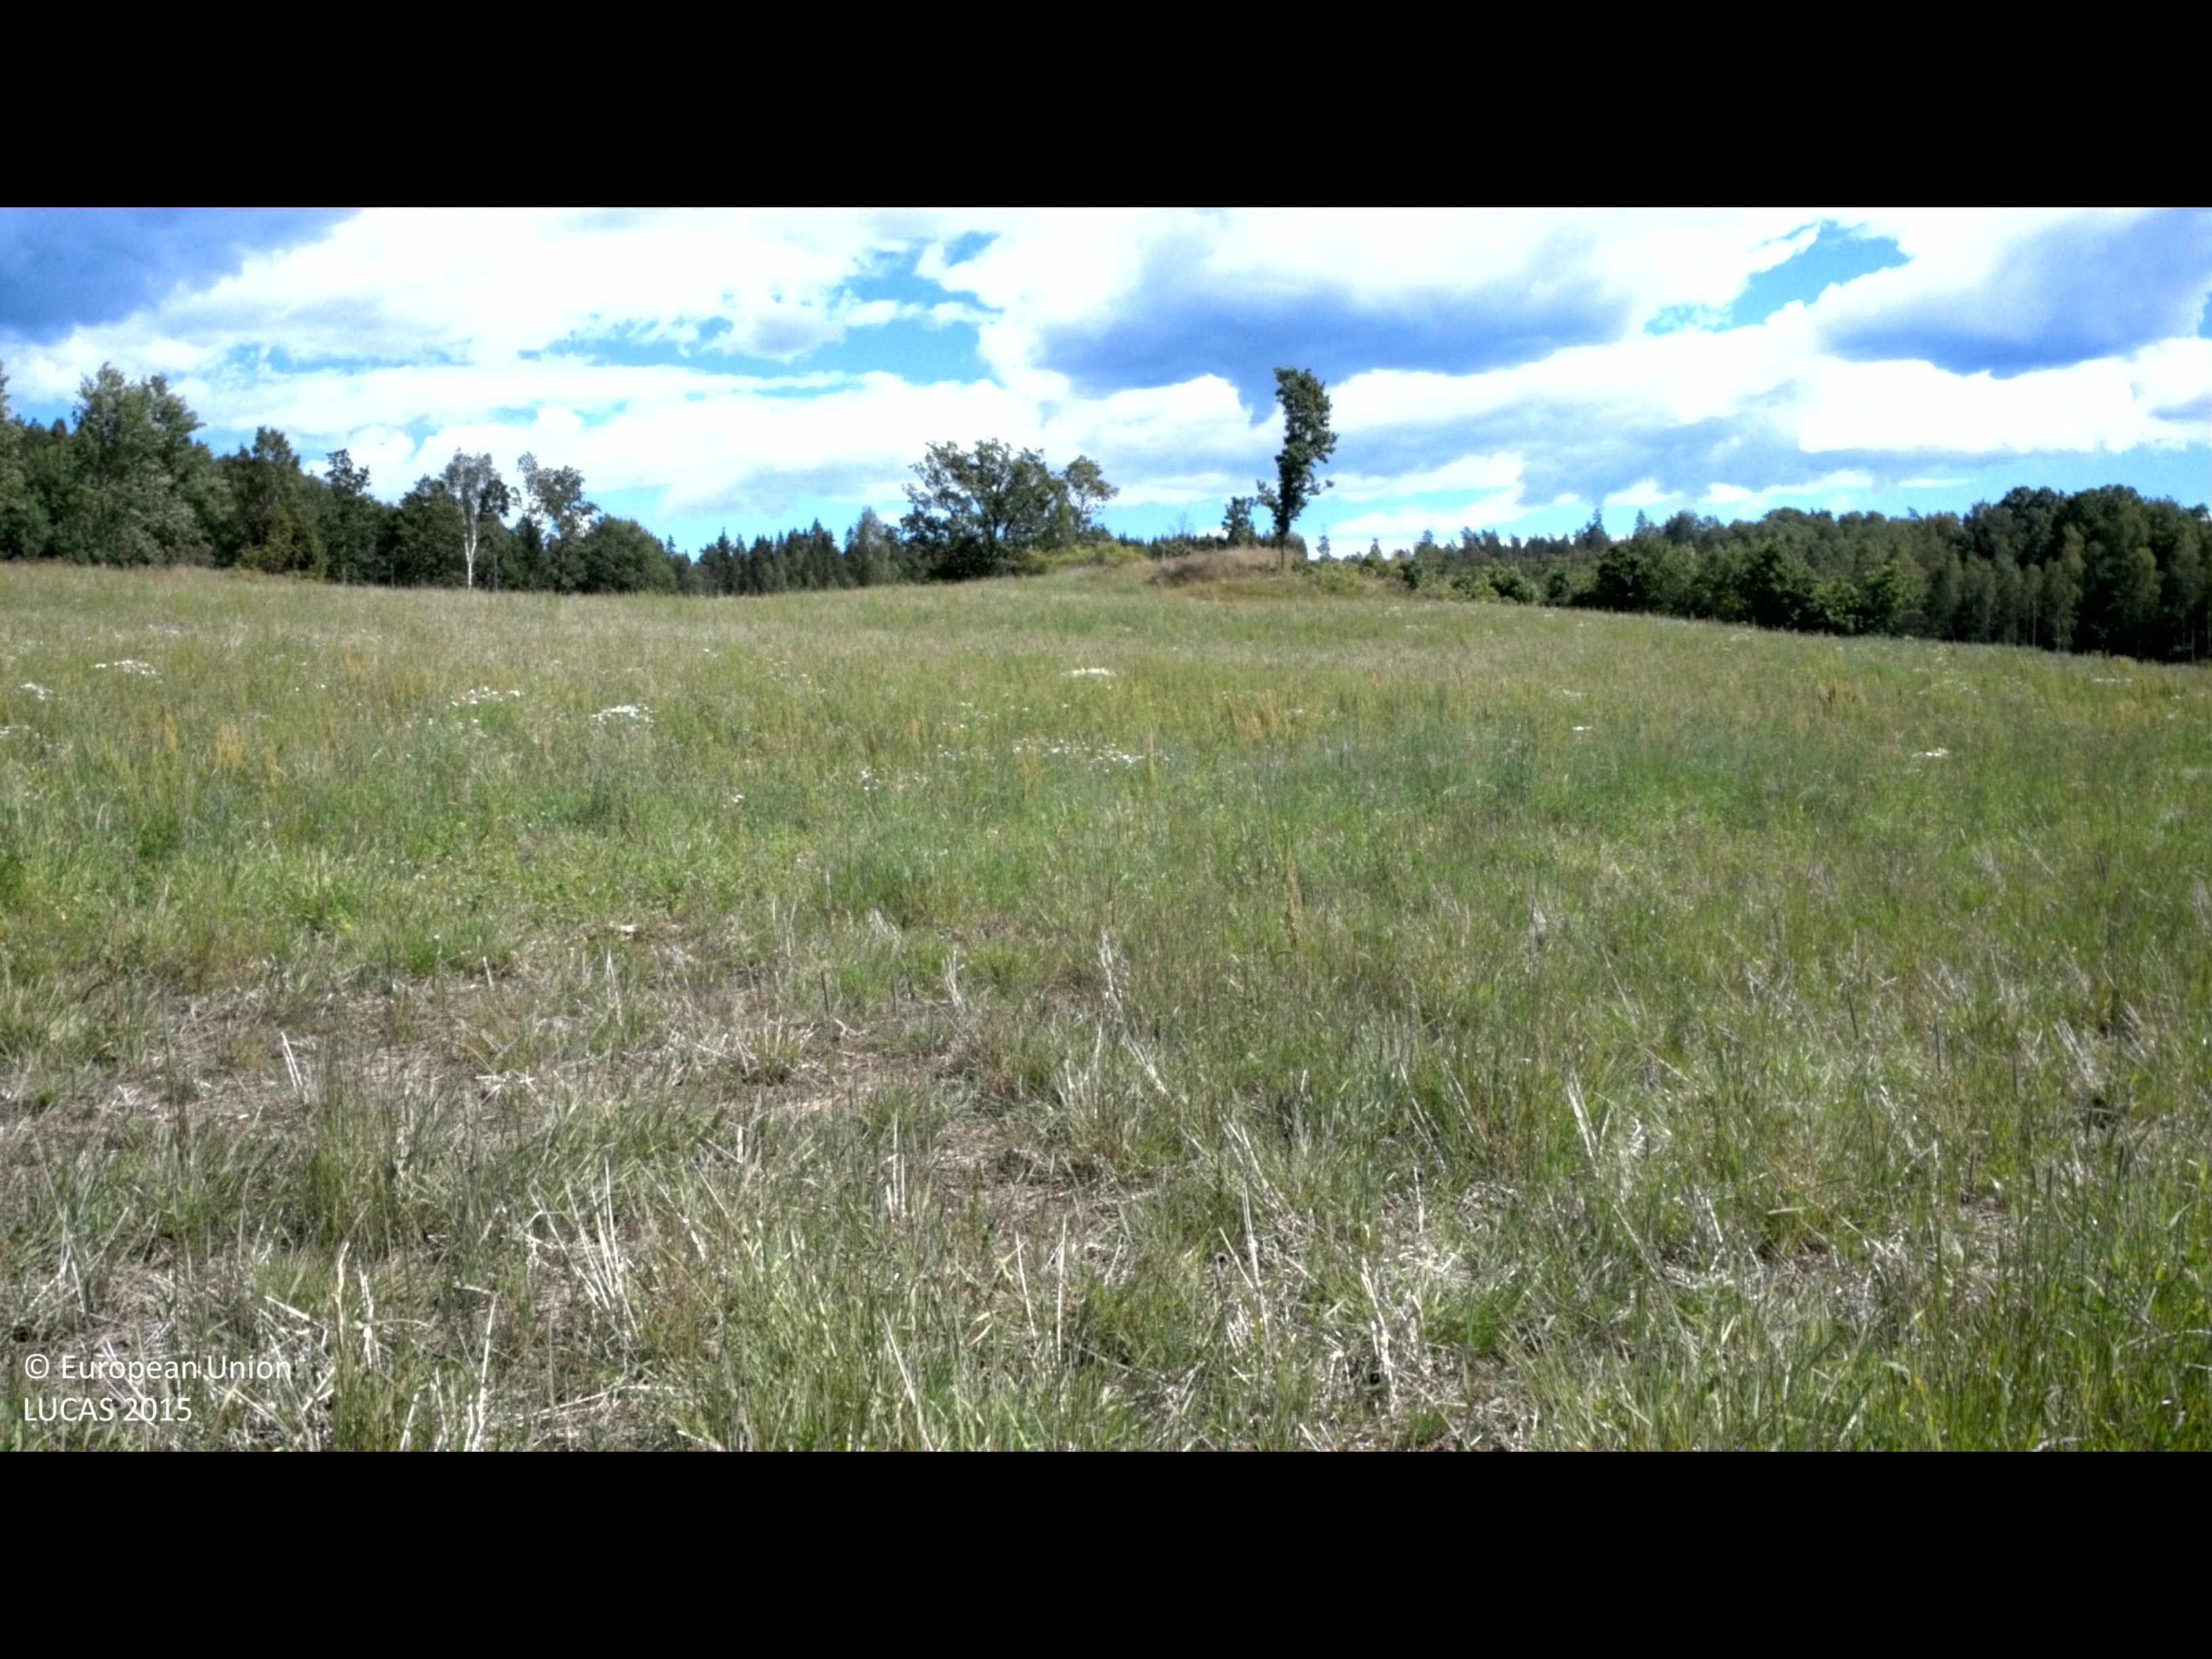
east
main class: Grassland
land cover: Spontaneously vegetated surfaces
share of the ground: > 75 %
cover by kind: herbaceous plants 90 %, unconsolidated bare surface 10 %
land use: Fallow land
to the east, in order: Spontaneously vegetated surfaces; Grassland with sparse tree/shrub cover; Broadleaved woodland; Electric lines; Broadleaved woodland; Grass margins; Paved roads, cycling and walking lanes; Grassland with sparse tree/shrub cover; Grassland without tree/shrub cover; Ditches and canals; Temporary grasslands
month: July
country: SE
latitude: 58.2499
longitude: 16.3518
